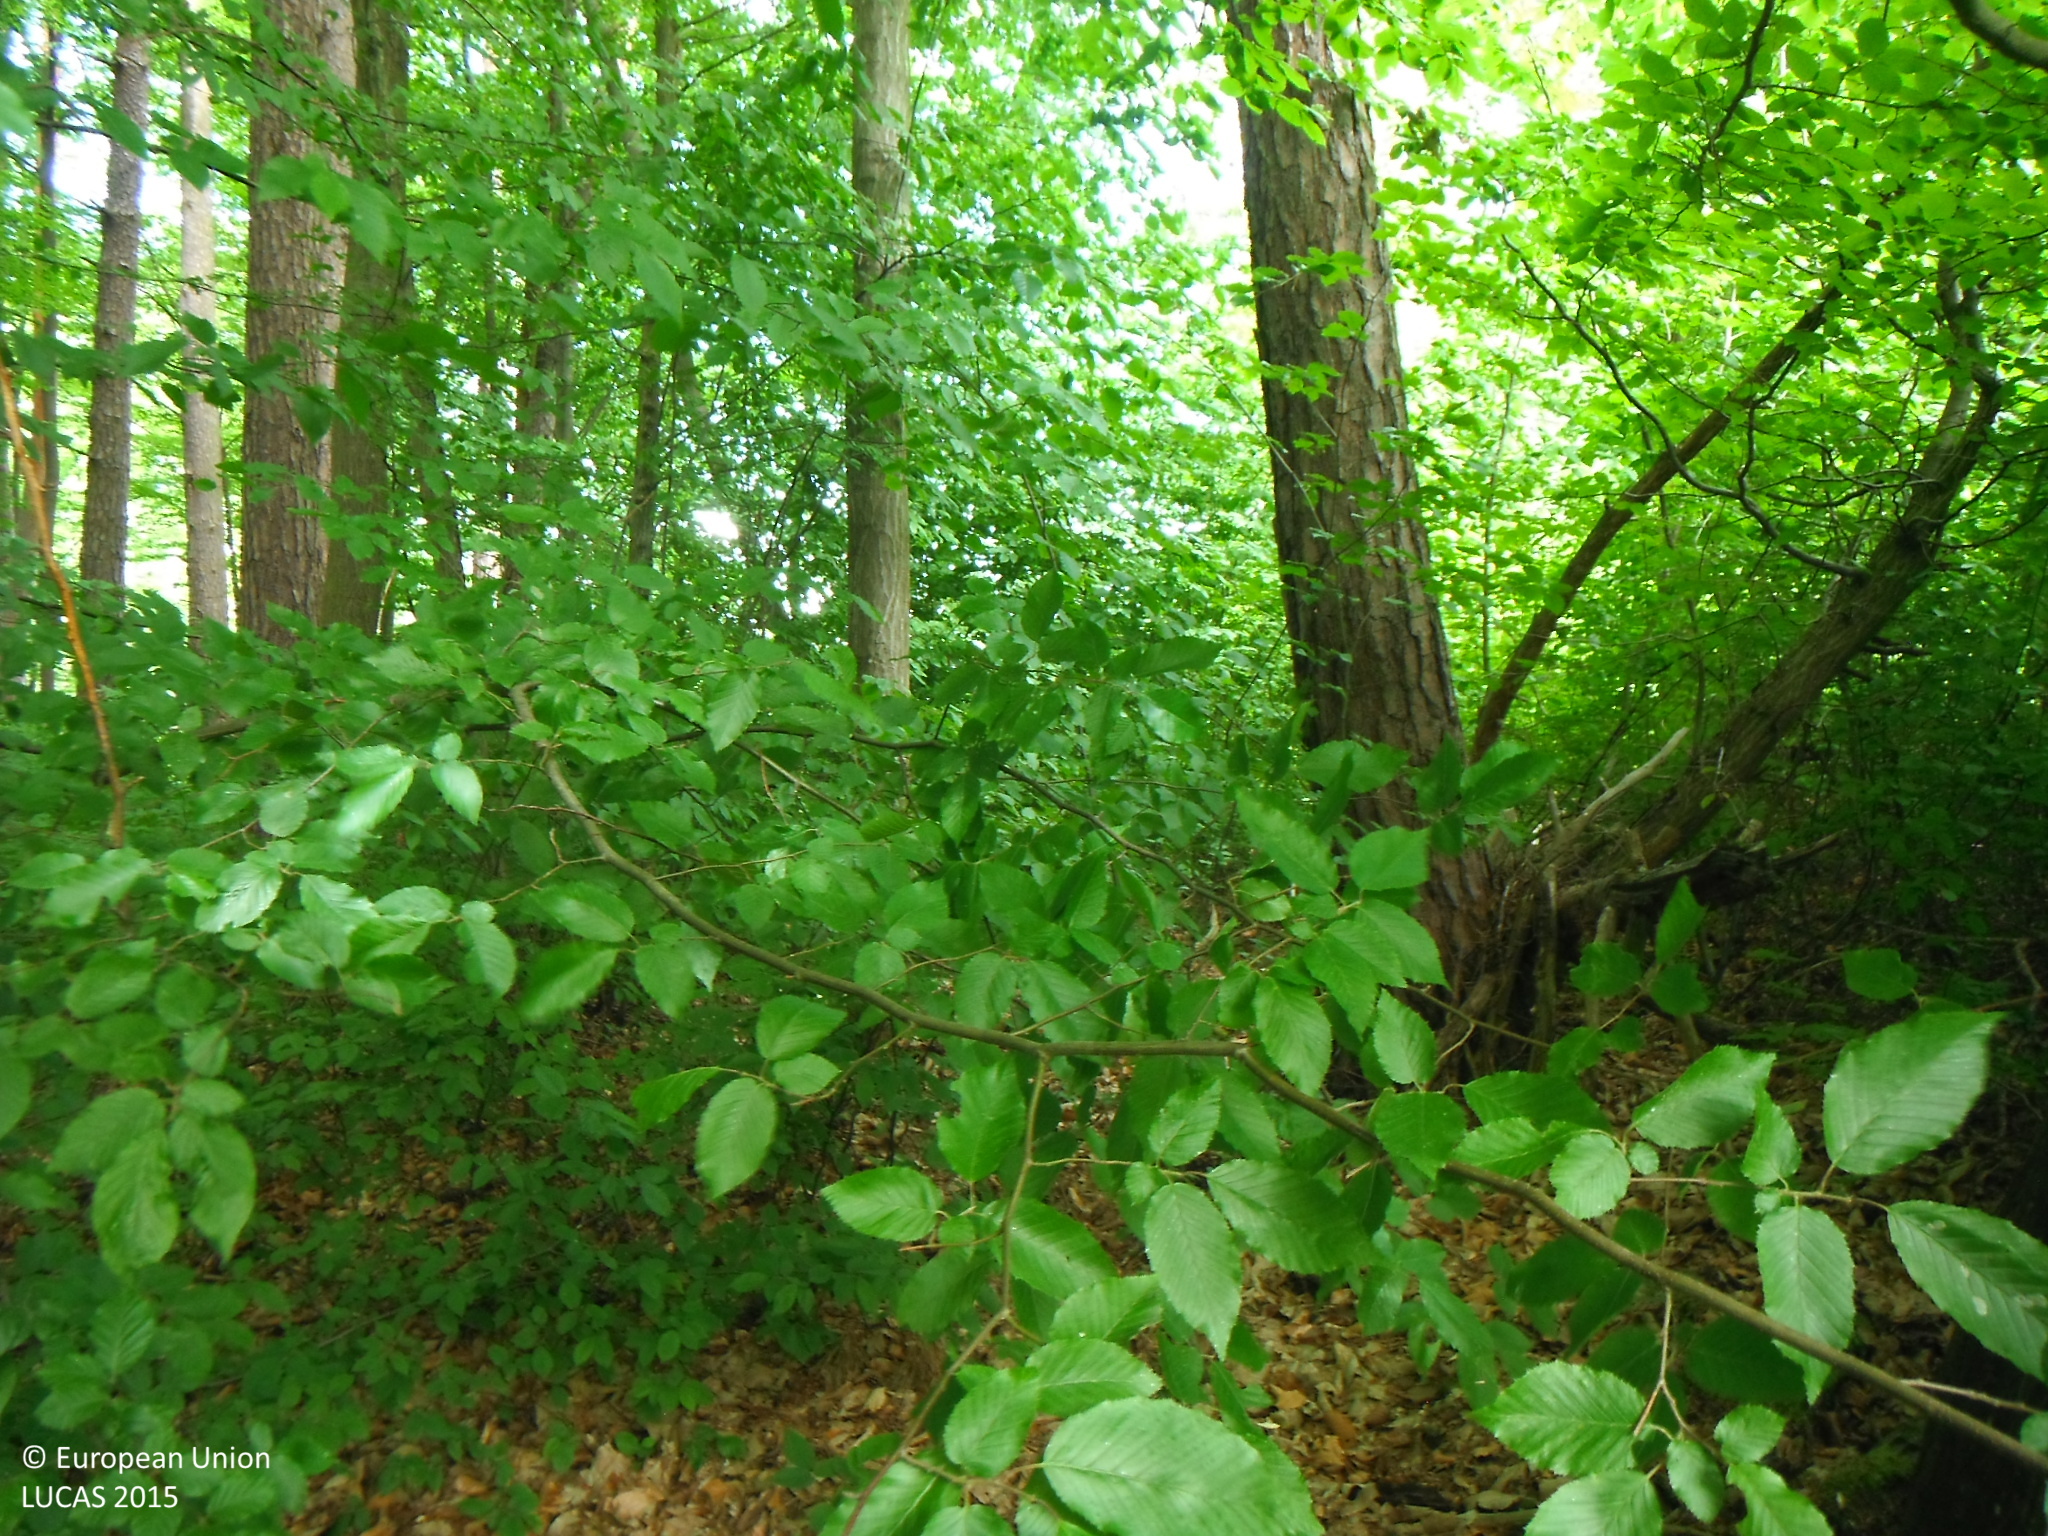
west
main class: Woodland
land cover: Broadleaved woodland
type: beech forest
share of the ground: > 75 %
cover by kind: broadleaved forest trees 75 %, shrubs 25 %
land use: Forestry
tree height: > 5 m
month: June
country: SK
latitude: 49.0919
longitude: 22.0109
